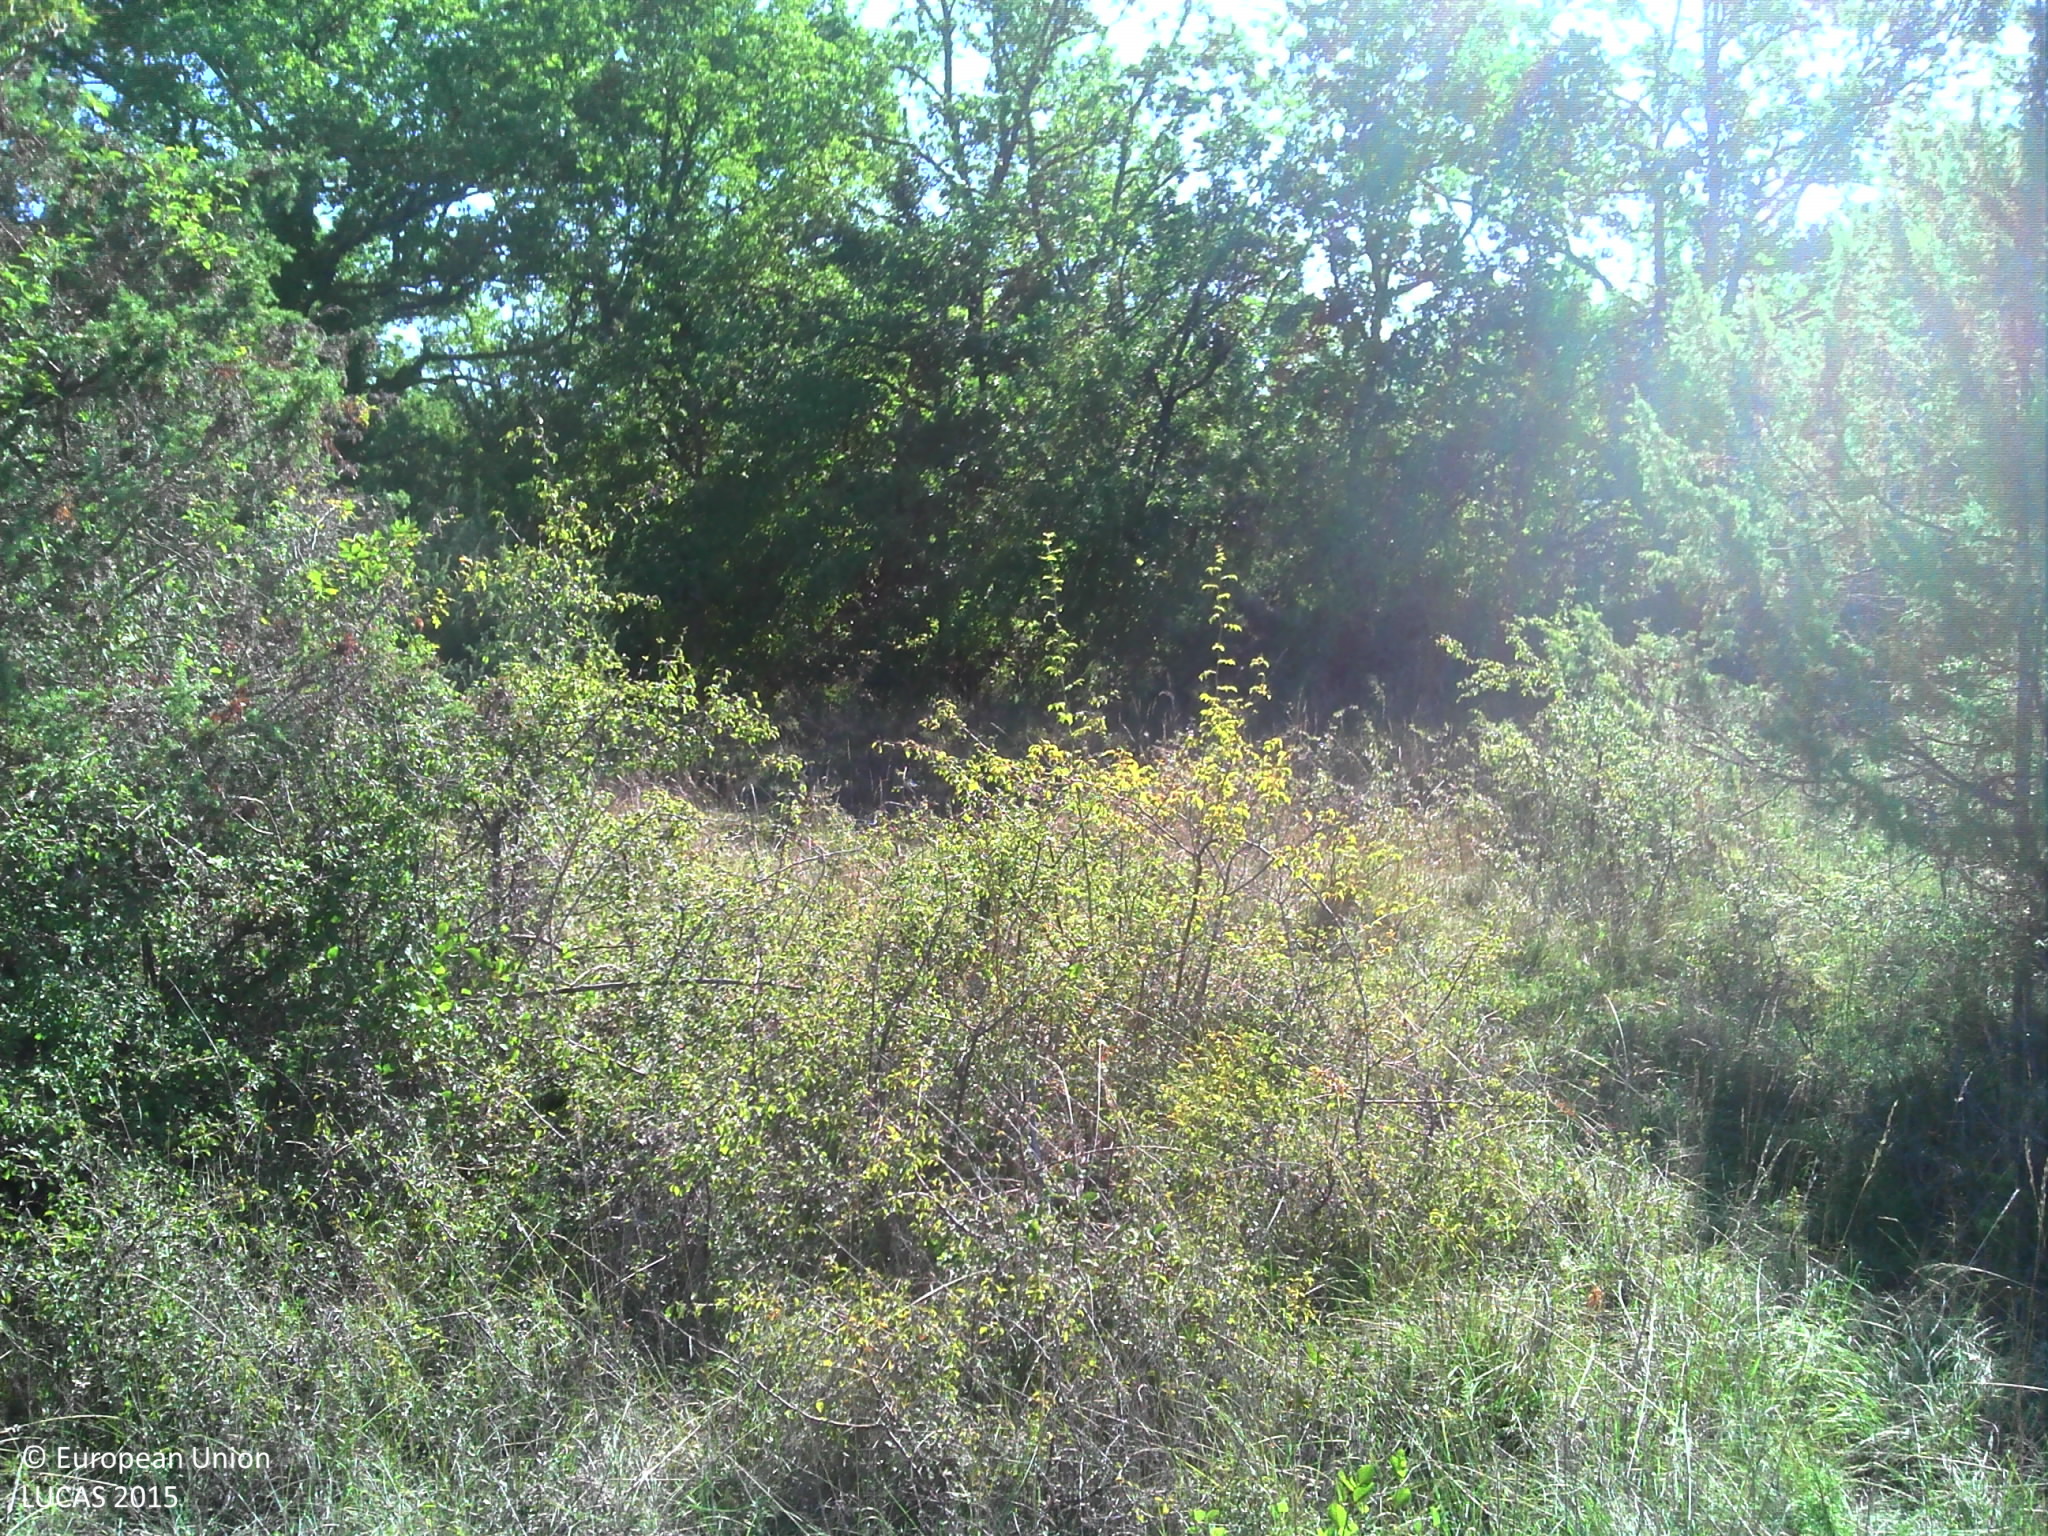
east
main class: Grassland
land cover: Grassland with sparse tree/shrub cover
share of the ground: > 75 %
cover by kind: herbaceous plants 85 %, shrubs 10 %, broadleaved forest trees 5 %
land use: Agriculture (excluding fallow land and kitchen gardens)
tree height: > 5 m
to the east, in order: Grassland with sparse tree/shrub cover; Broadleaved woodland; Dry stone walls; Grass margins; Tracks; Grass margins; Dry stone walls; Broadleaved woodland; Dry stone walls; Fences; Broadleaved woodland; Dry stone walls; Broadleaved woodland; Grassland with sparse tree/shrub cover; Broadleaved woodland; Grassland with sparse tree/shrub cover; Broadleaved woodland
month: August
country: FR
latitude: 44.3564
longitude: 1.6312
